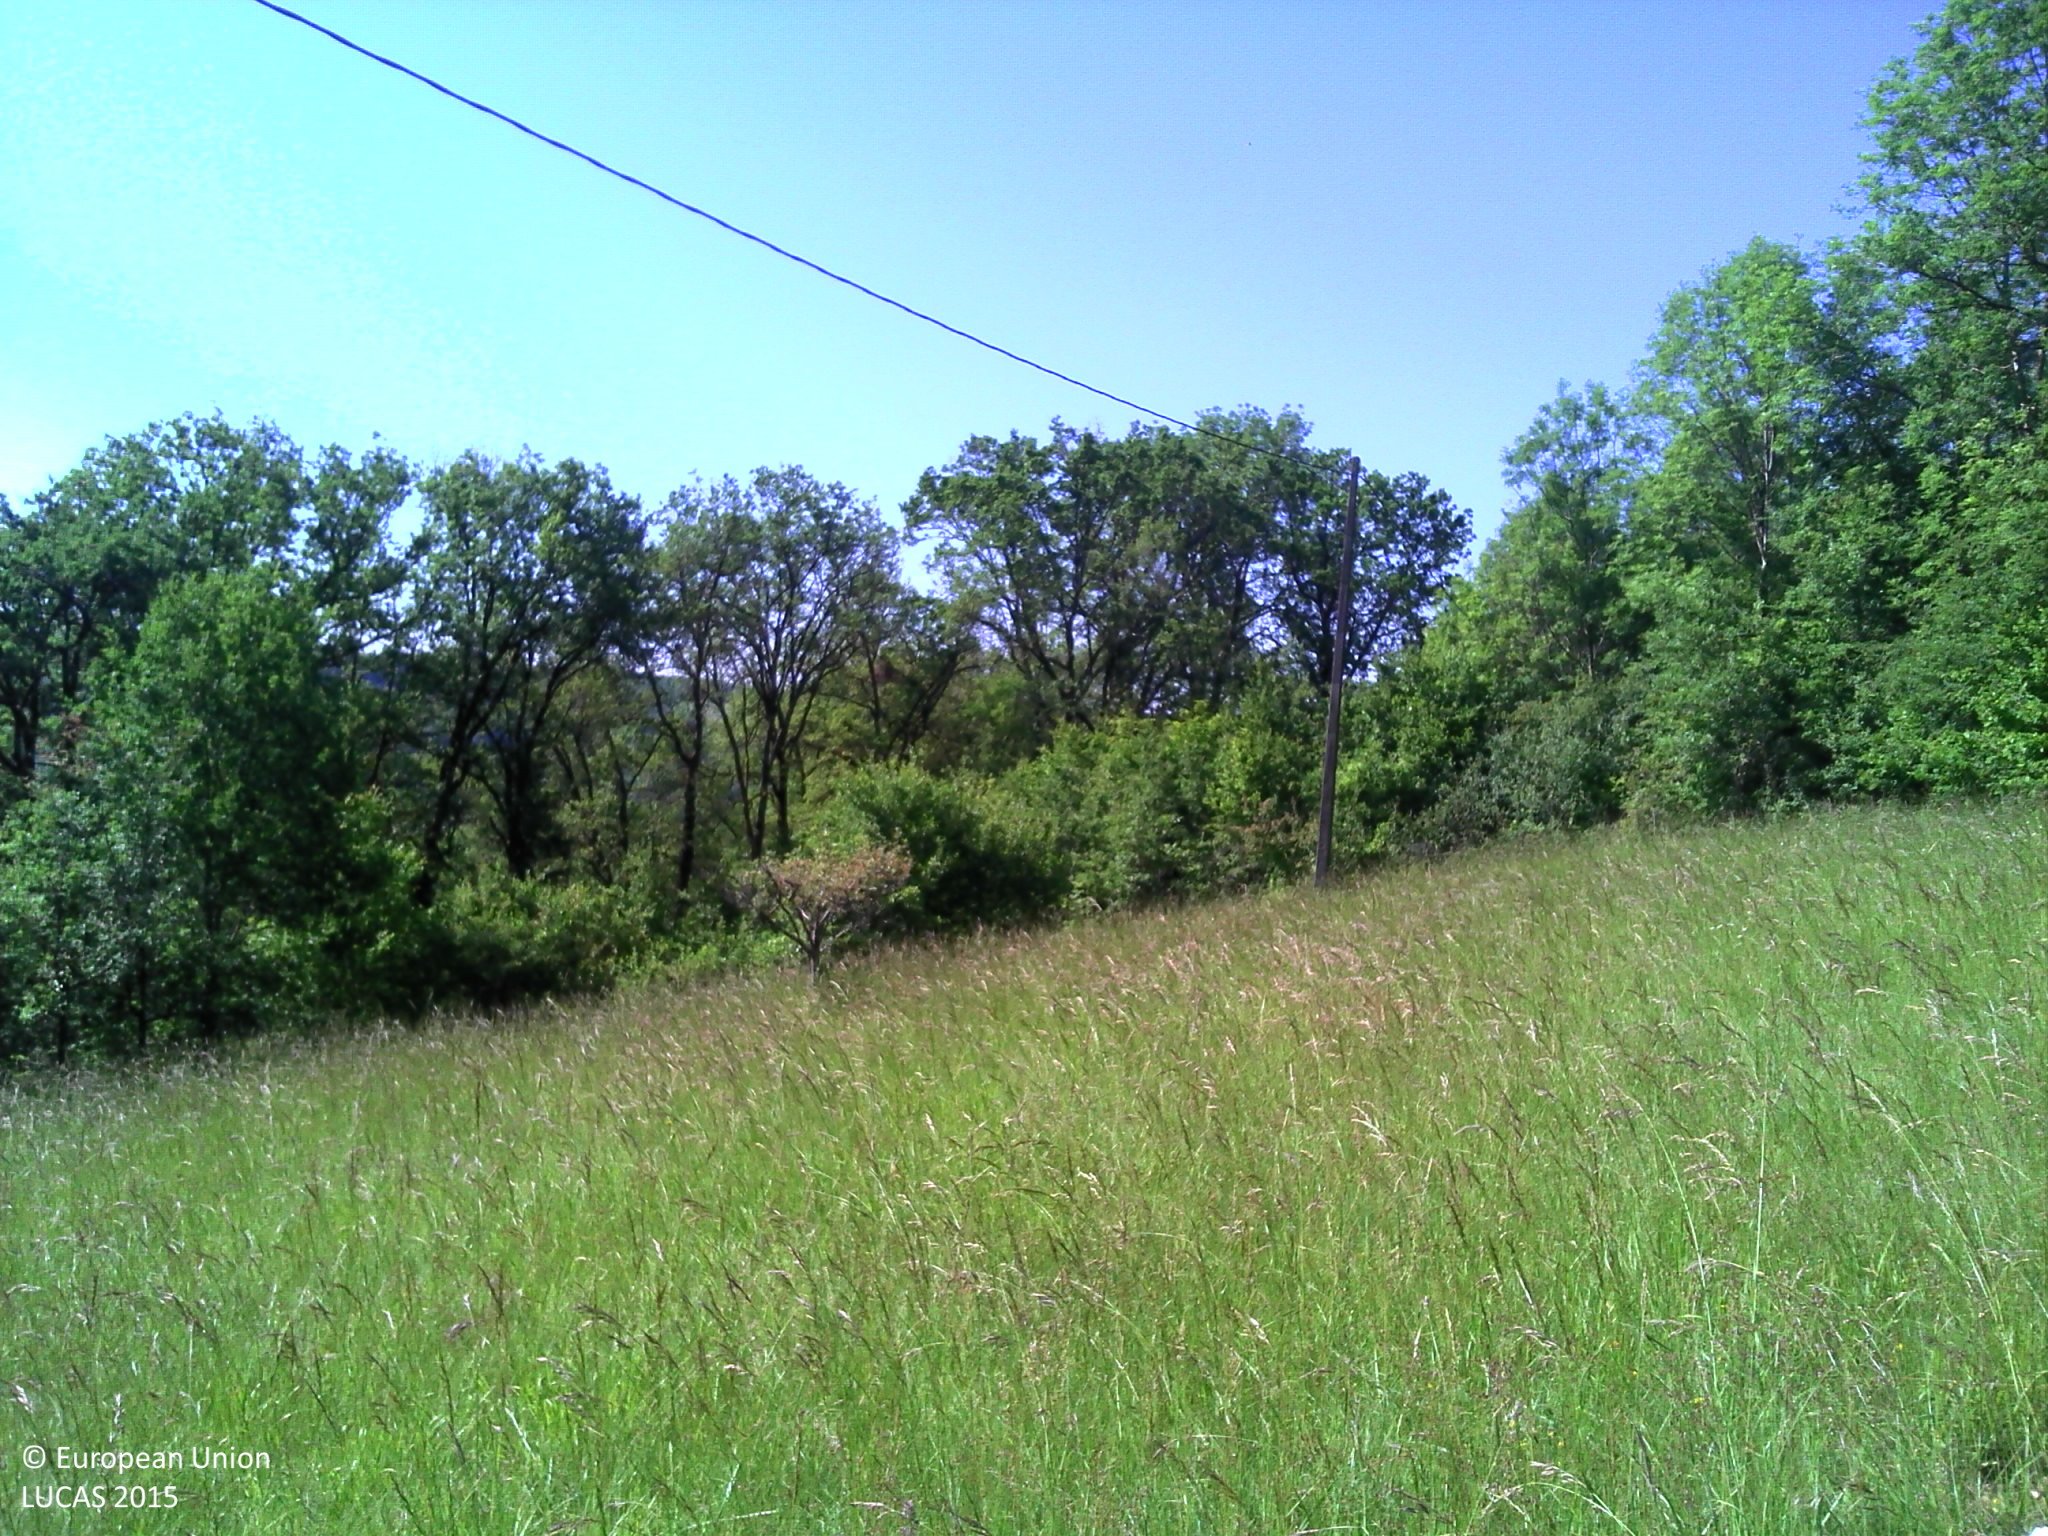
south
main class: Grassland
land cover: Grassland without tree/shrub cover
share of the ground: > 75 %
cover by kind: herbaceous plants 100 %
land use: Agriculture (excluding fallow land and kitchen gardens)
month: May
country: FR
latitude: 44.5671
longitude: 2.0047
